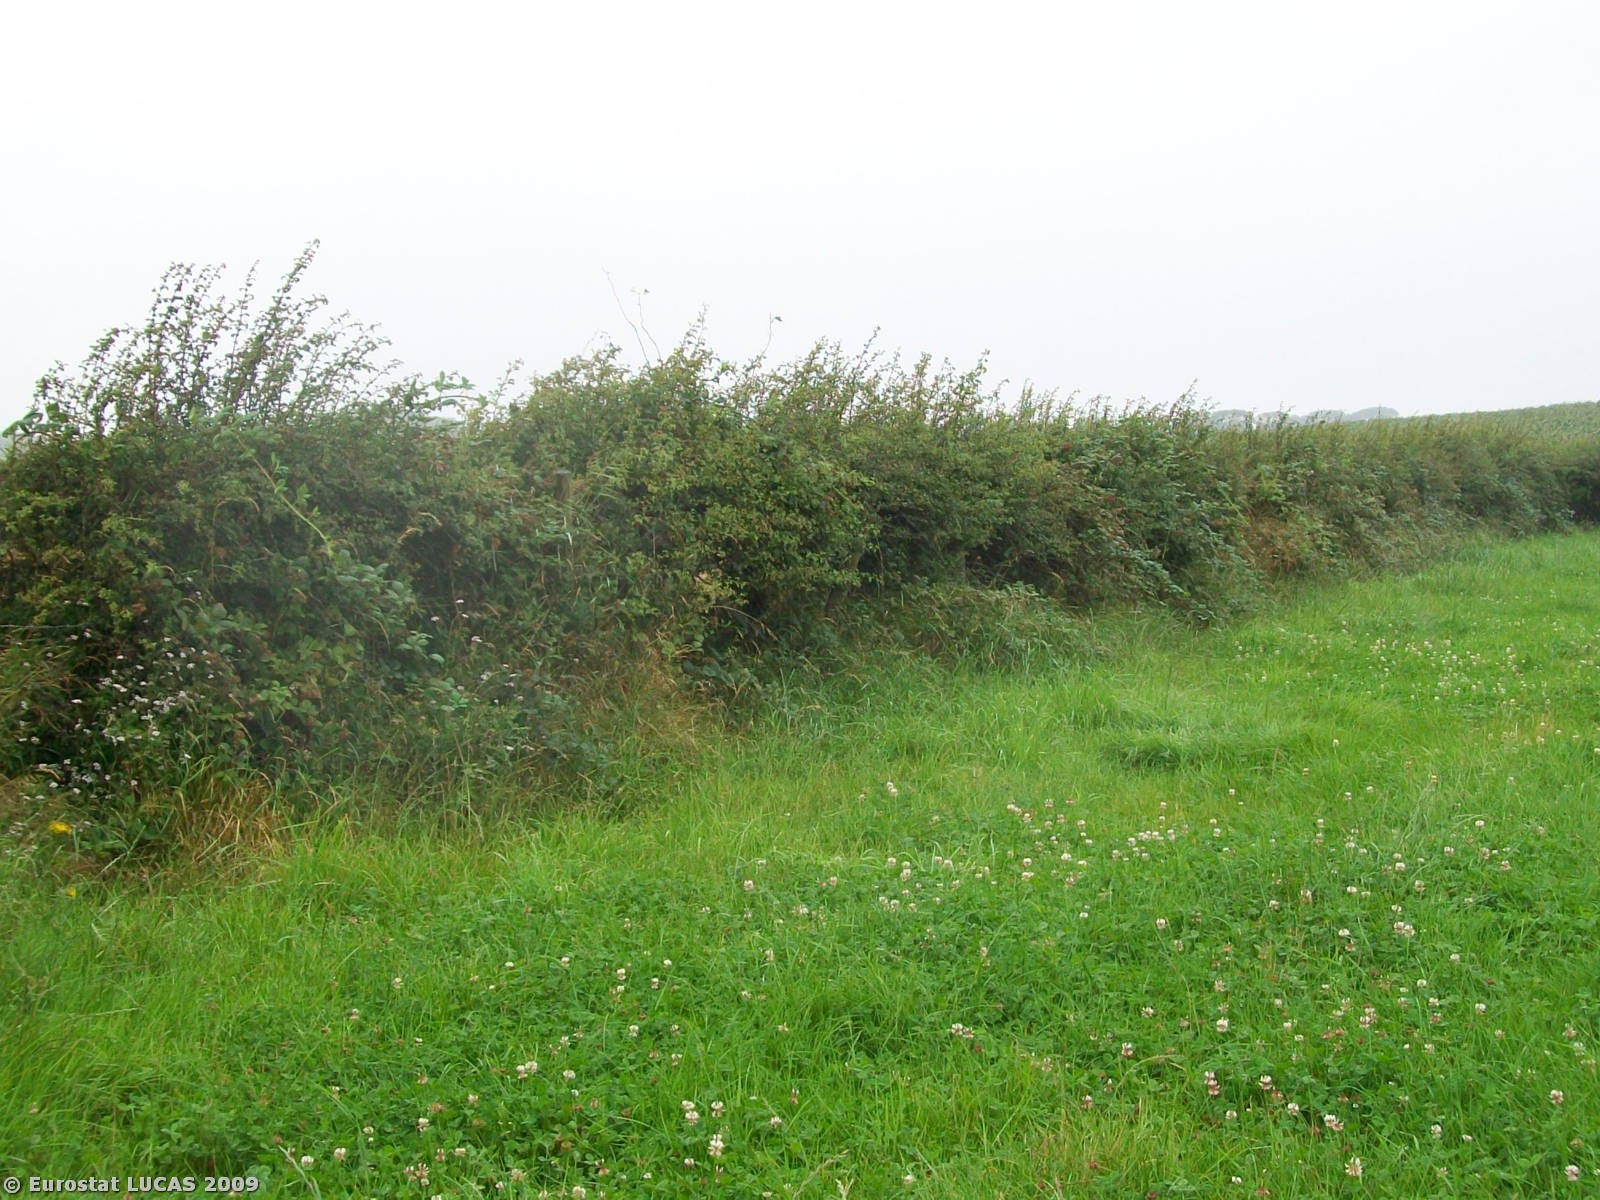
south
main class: Grassland
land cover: Grassland without tree/shrub cover
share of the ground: > 75 %
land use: Agriculture (excluding fallow land and kitchen gardens)
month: August
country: GB
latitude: 54.2852
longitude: -5.6304
